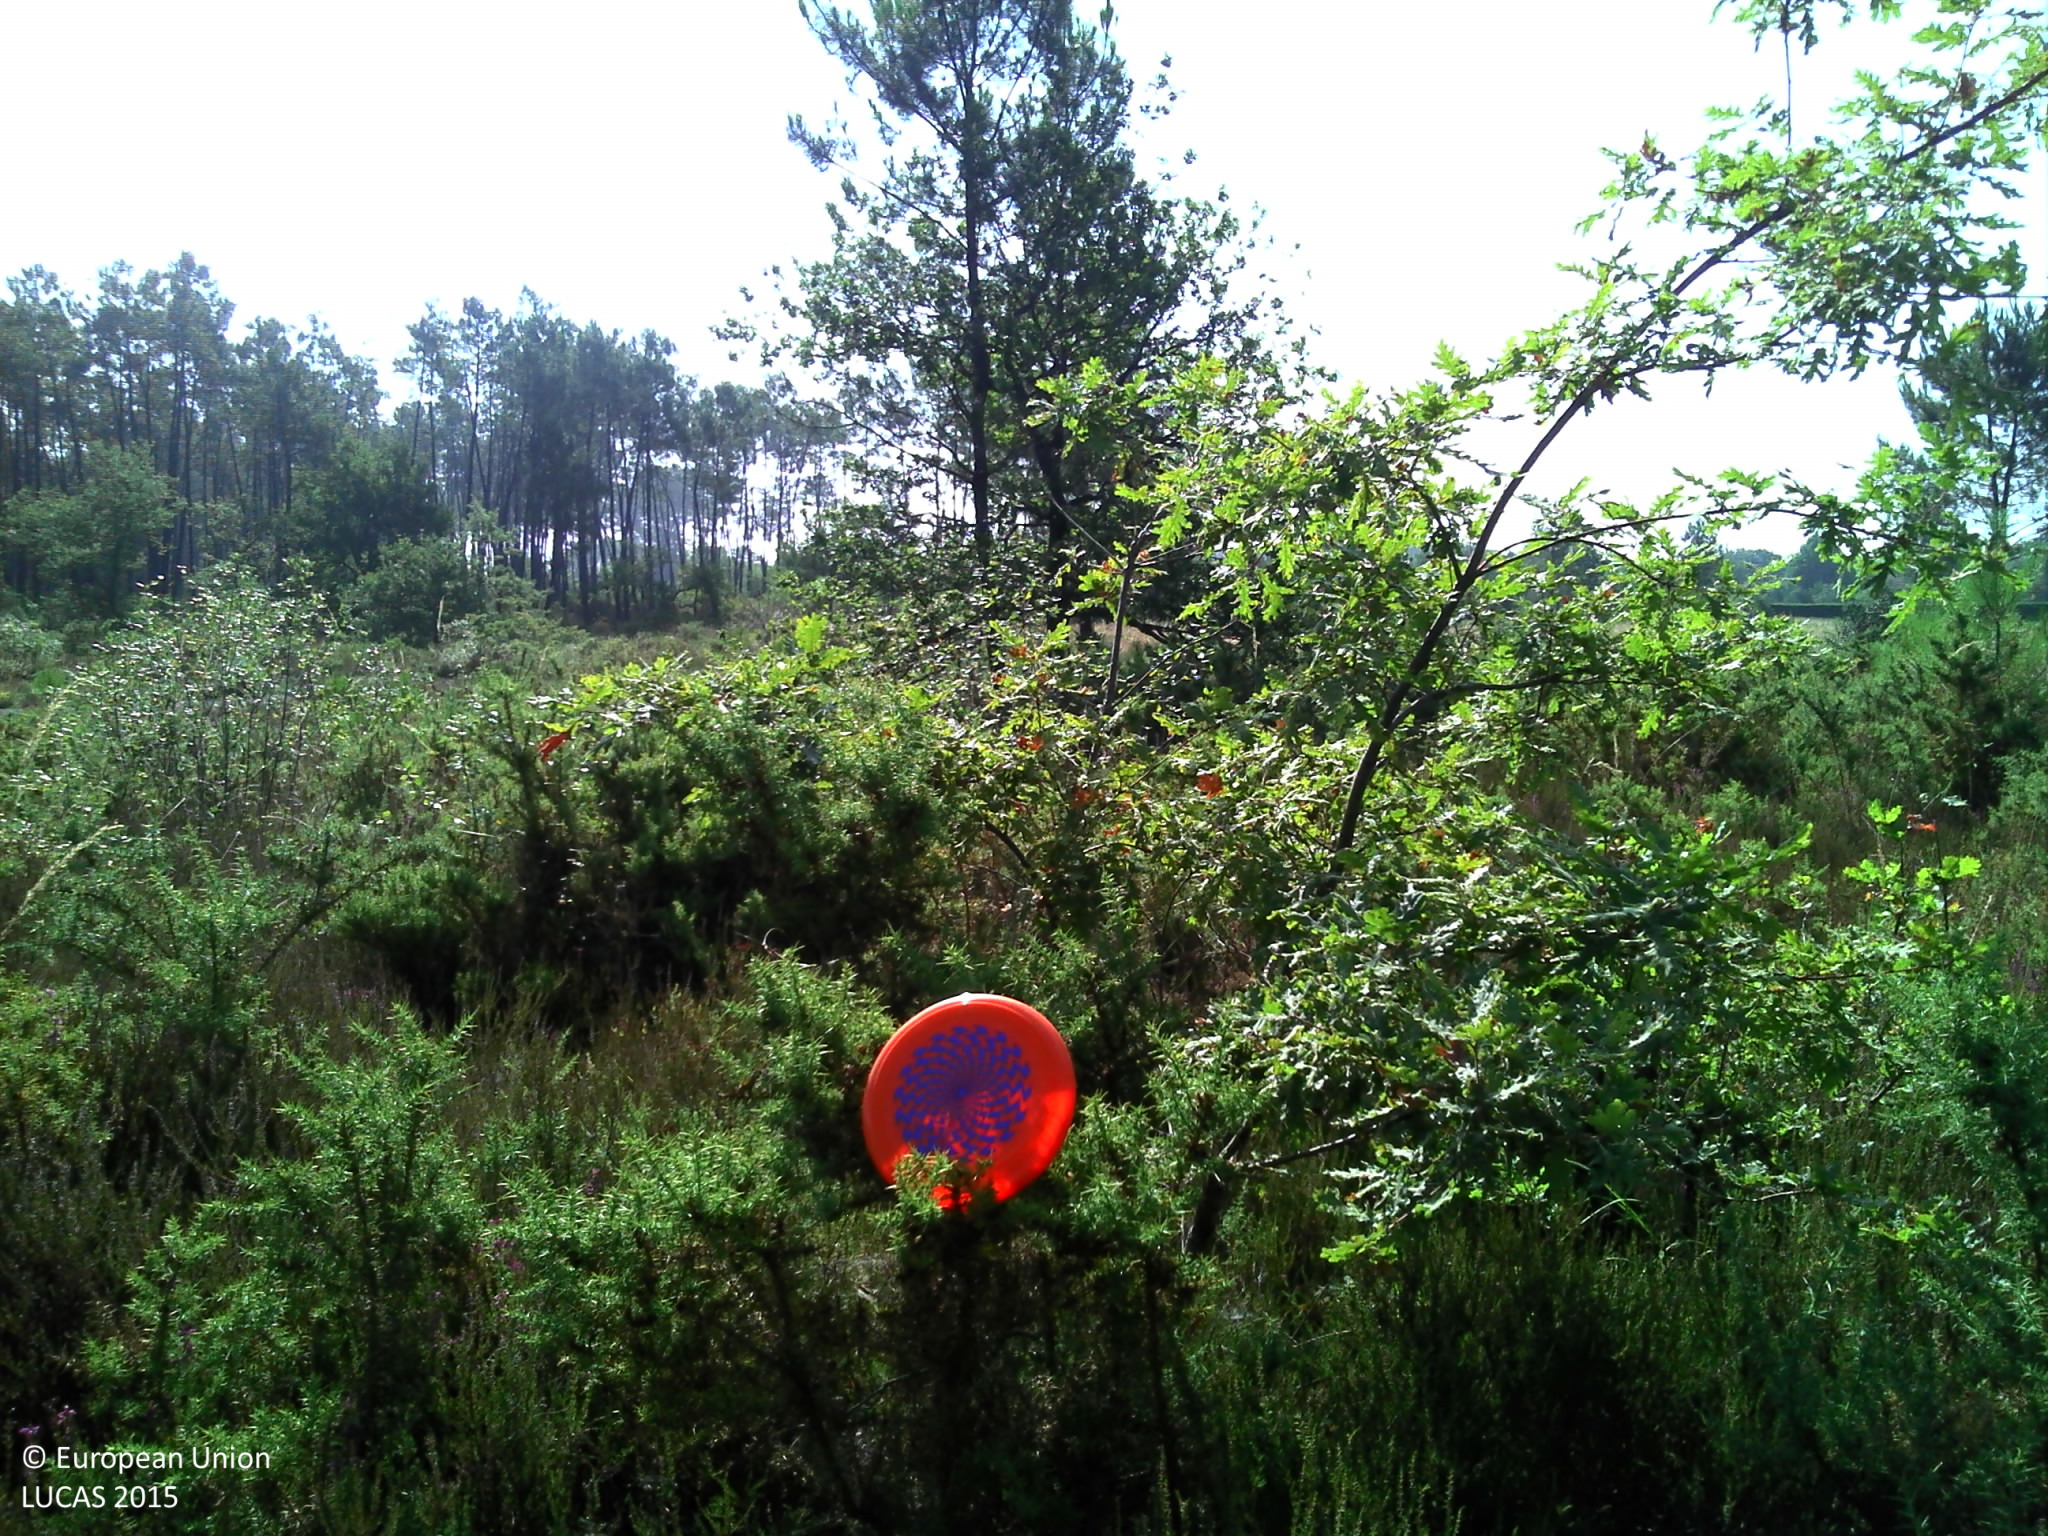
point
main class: Woodland
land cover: Broadleaved woodland
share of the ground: > 75 %
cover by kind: broadleaved forest trees 65 %, shrubs 15 %, herbaceous plants 15 %, coniferous forest trees 5 %
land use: Forestry
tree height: > 5 m
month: July
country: FR
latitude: 43.7141
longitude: -1.1246
